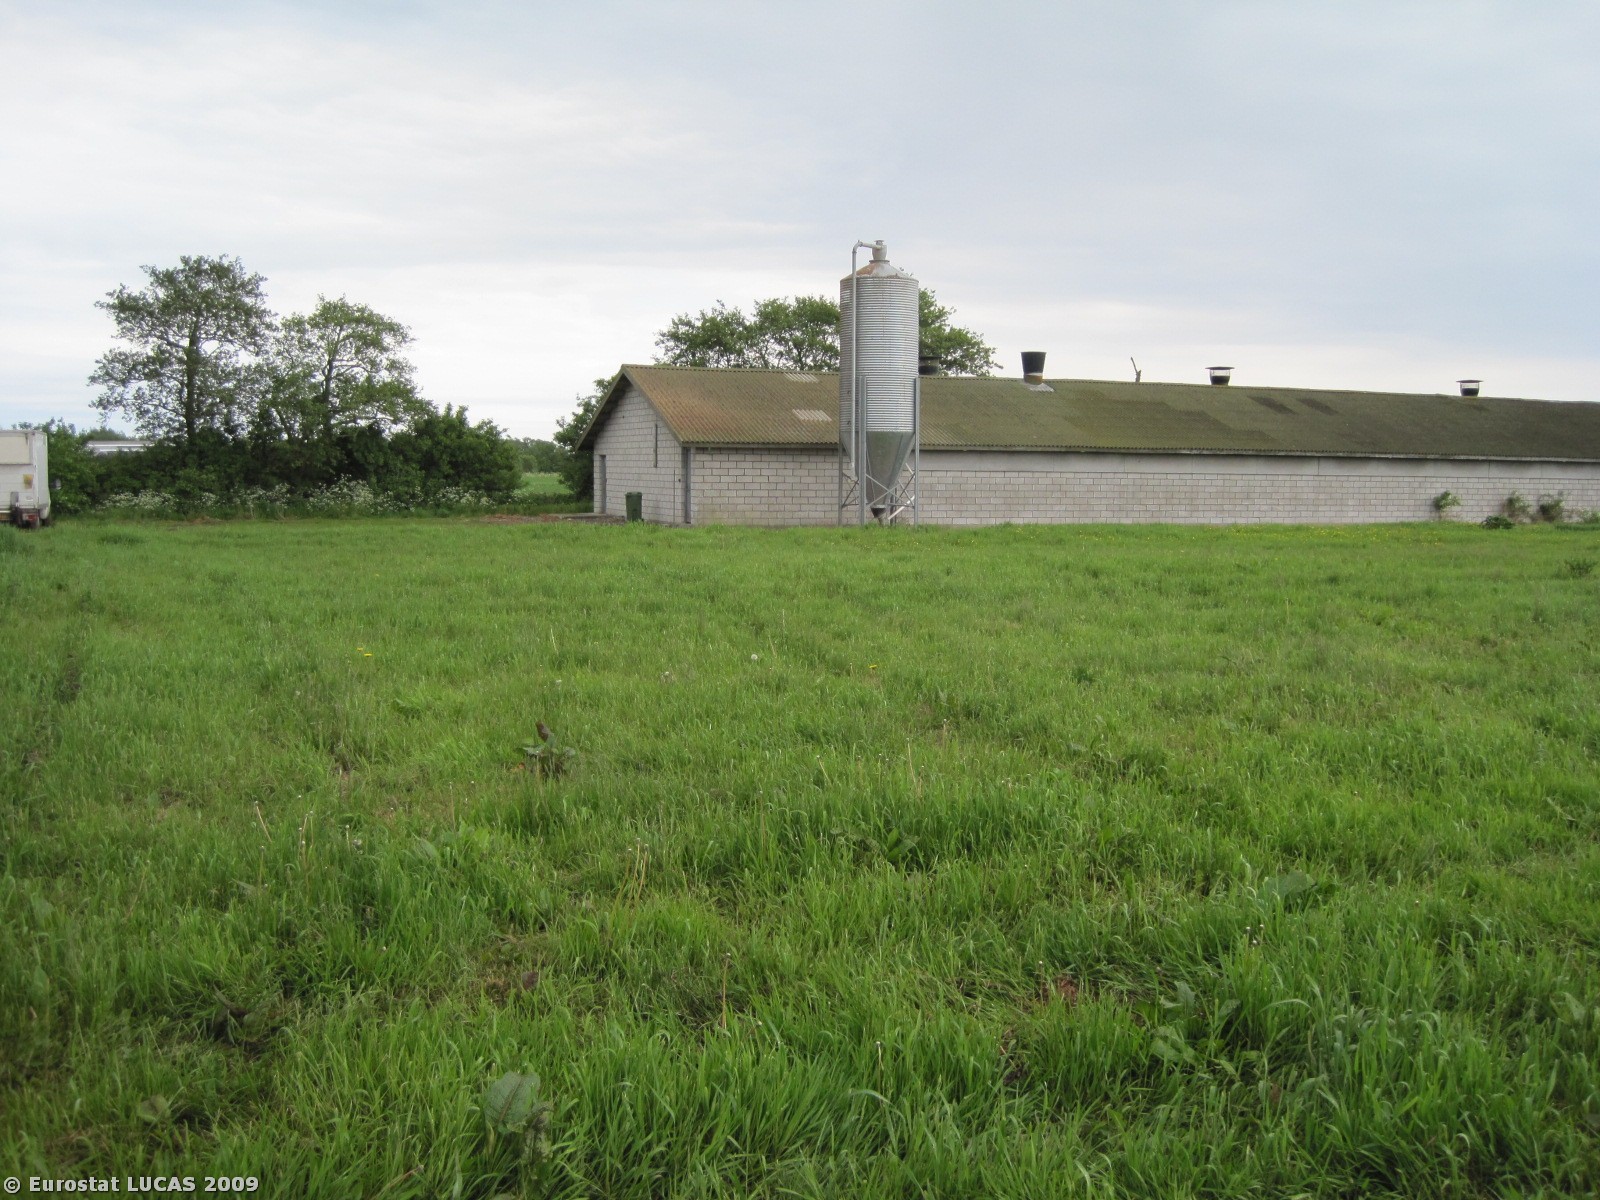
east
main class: Grassland
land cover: Grassland without tree/shrub cover
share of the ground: > 75 %
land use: Agriculture (excluding fallow land and kitchen gardens)
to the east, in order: Grassland without tree/shrub cover; Artificial constructions in urban areas; Grass margins; Broadleaved woodland; Barley
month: May
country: DK
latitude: 56.7808
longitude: 10.2125
